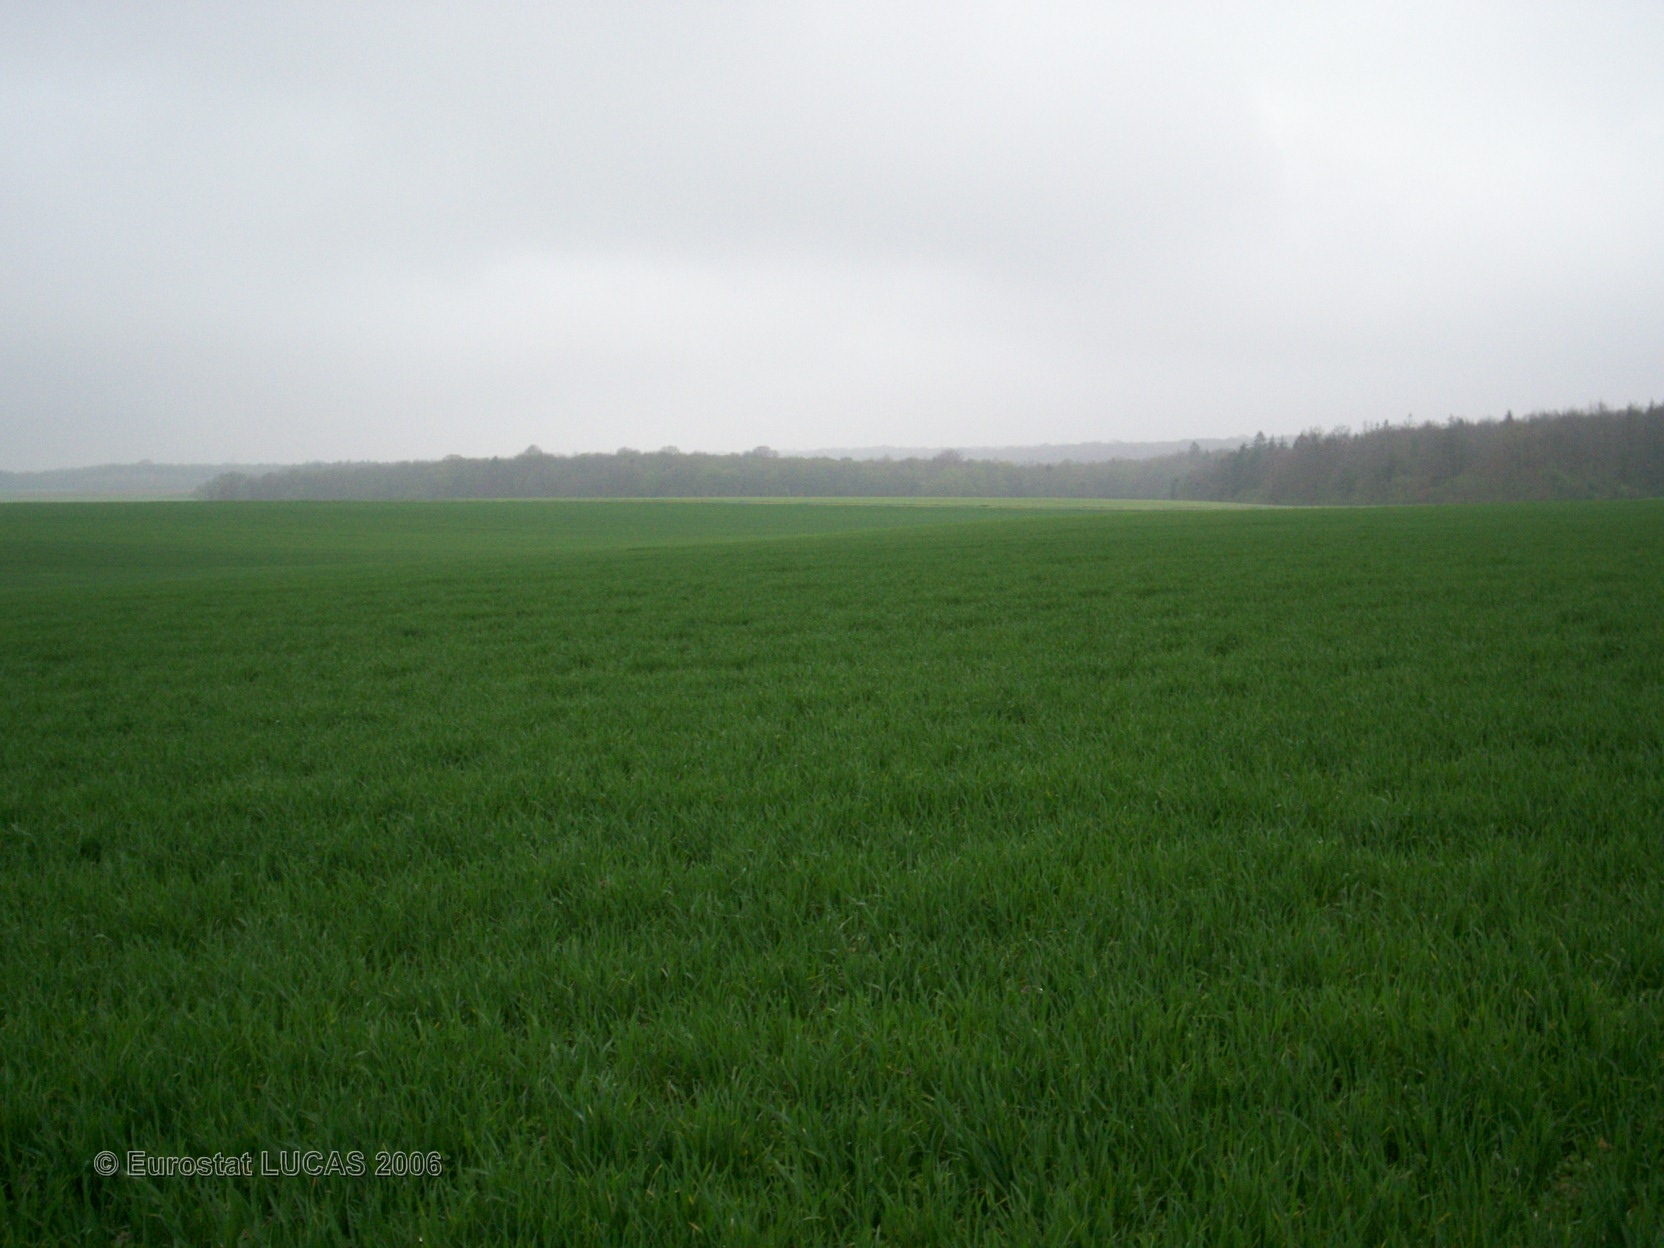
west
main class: Cropland
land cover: Common wheat
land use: Agriculture (excluding fallow land and kitchen gardens)
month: April
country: FR
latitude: 47.7803
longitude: 4.5132
